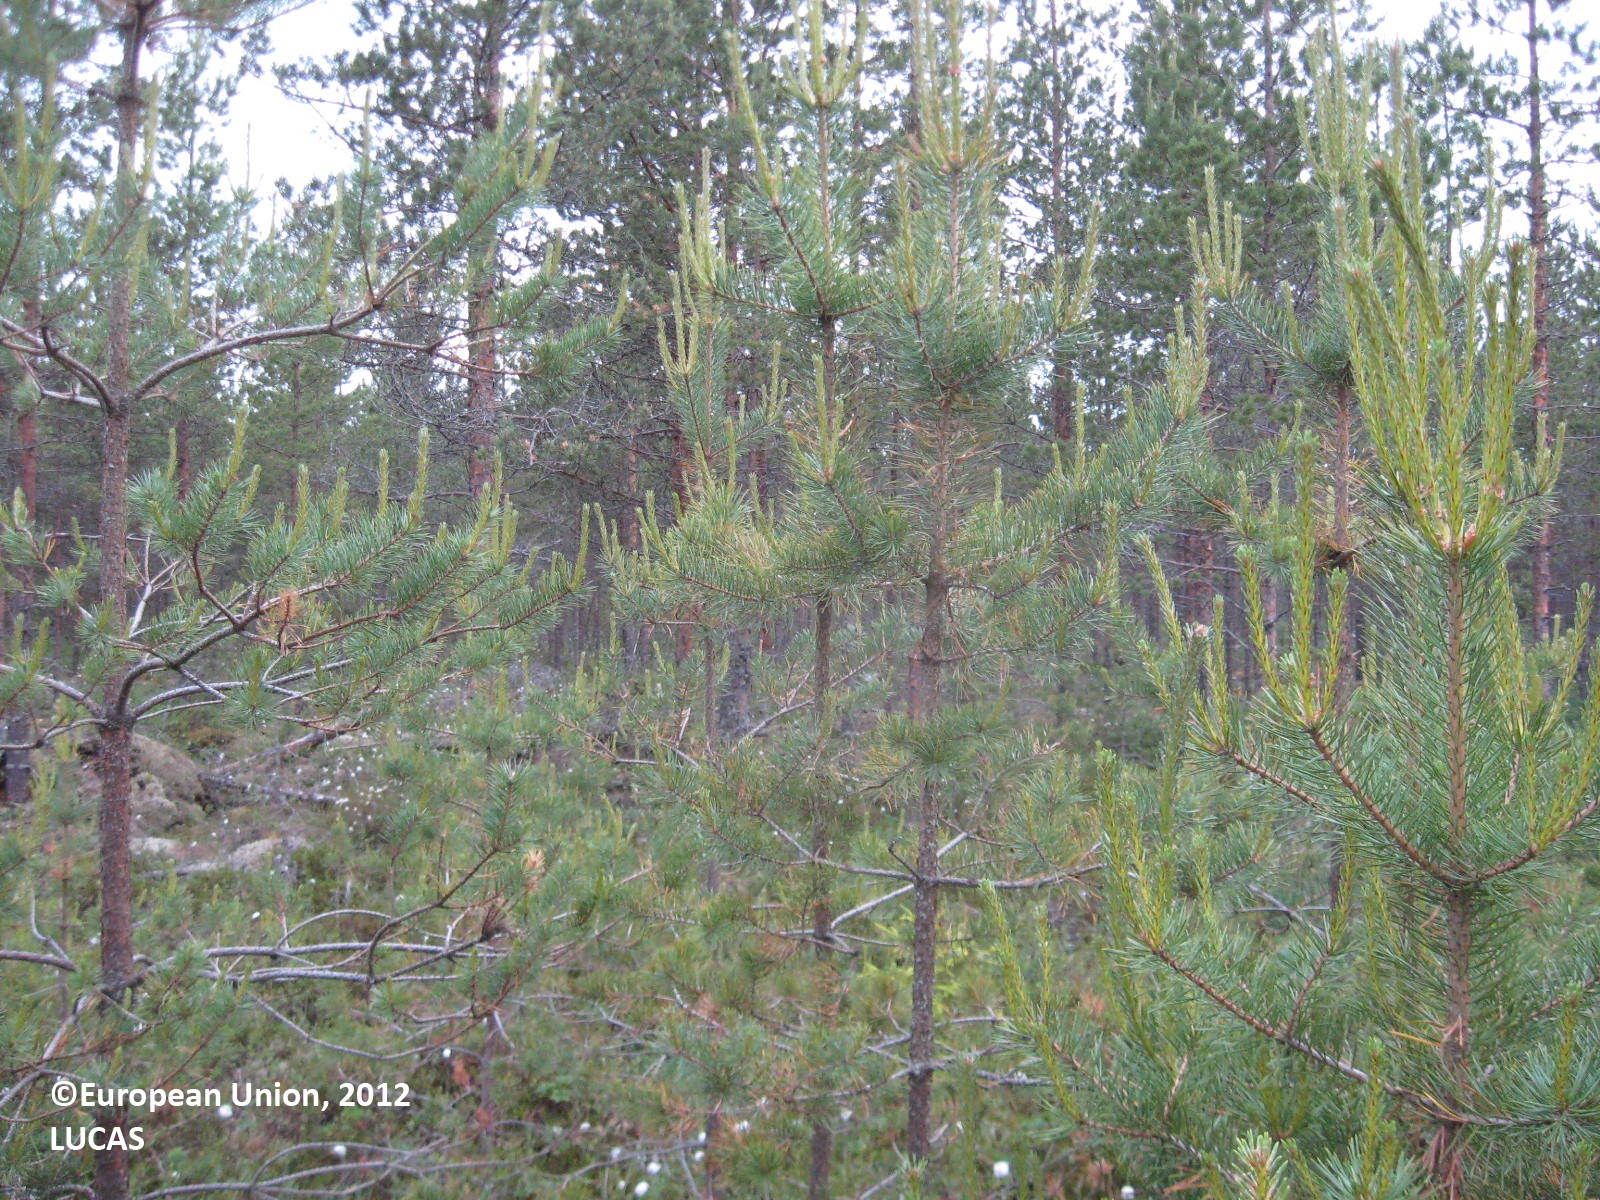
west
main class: Woodland
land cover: Pine dominated coniferous woodland
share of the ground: > 75 %
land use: Forestry
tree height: < 5 m
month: June
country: FI
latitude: 62.8987
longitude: 22.6668
